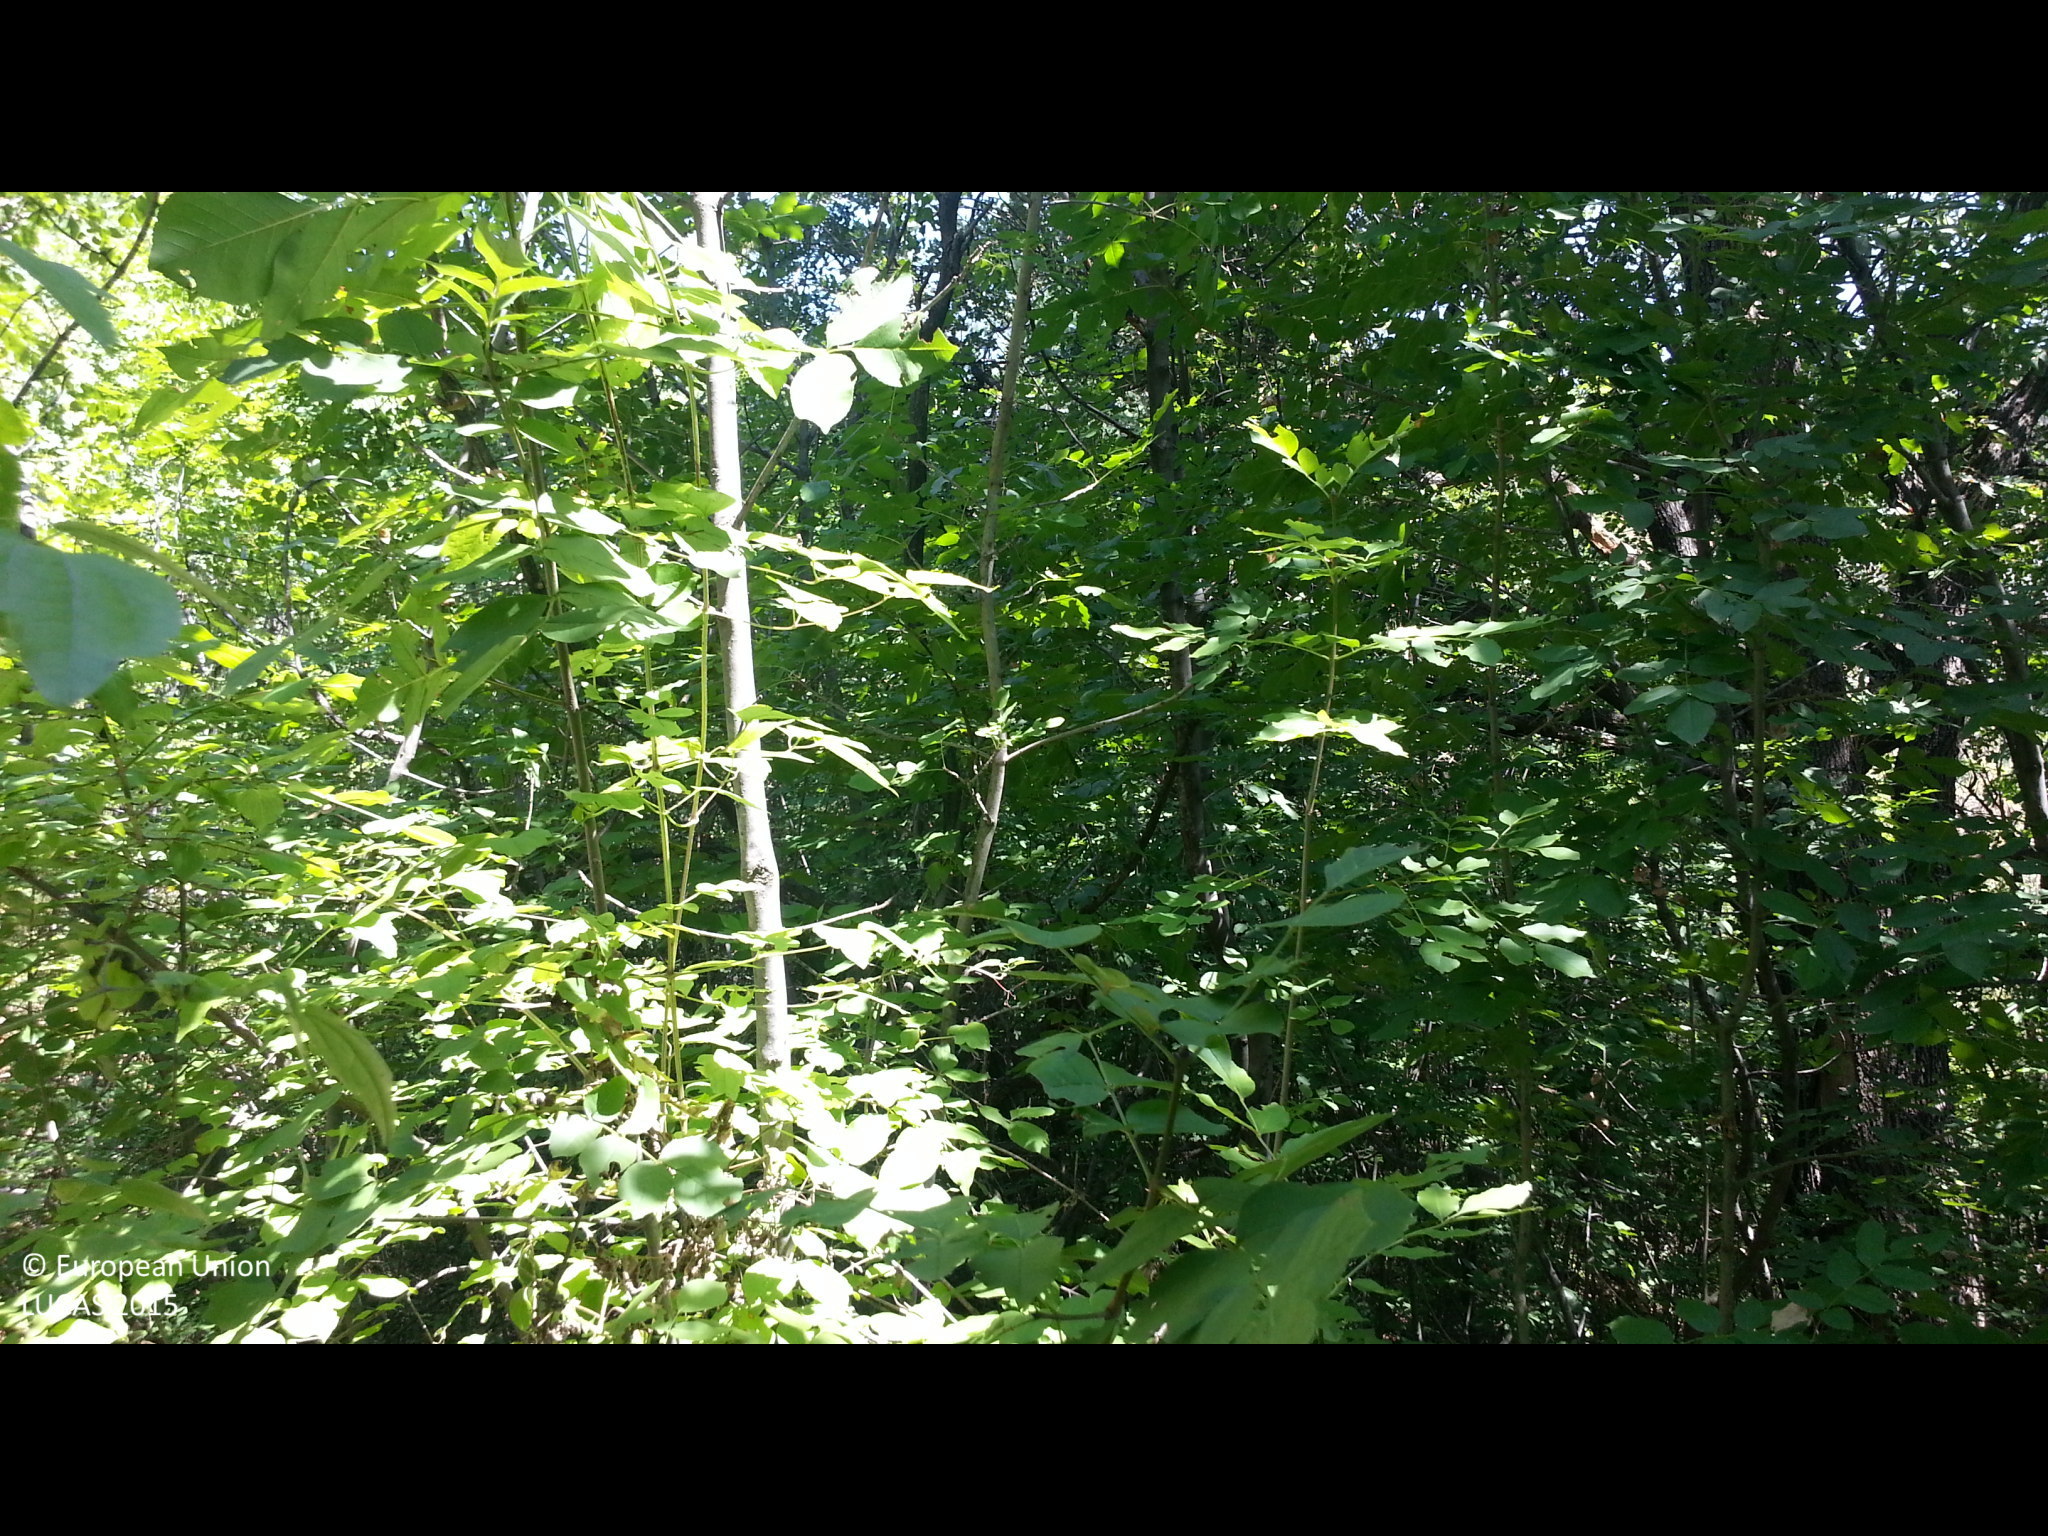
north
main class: Woodland
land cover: Pine dominated mixed woodland
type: hemiboreal forest and nemoral coniferous forest and mixed broadleaved-coniferous forest
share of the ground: > 75 %
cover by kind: coniferous forest trees 75 %, broadleaved forest trees 25 %
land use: Forestry
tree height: > 5 m
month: August
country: BG
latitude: 42.5278
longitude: 23.1167
